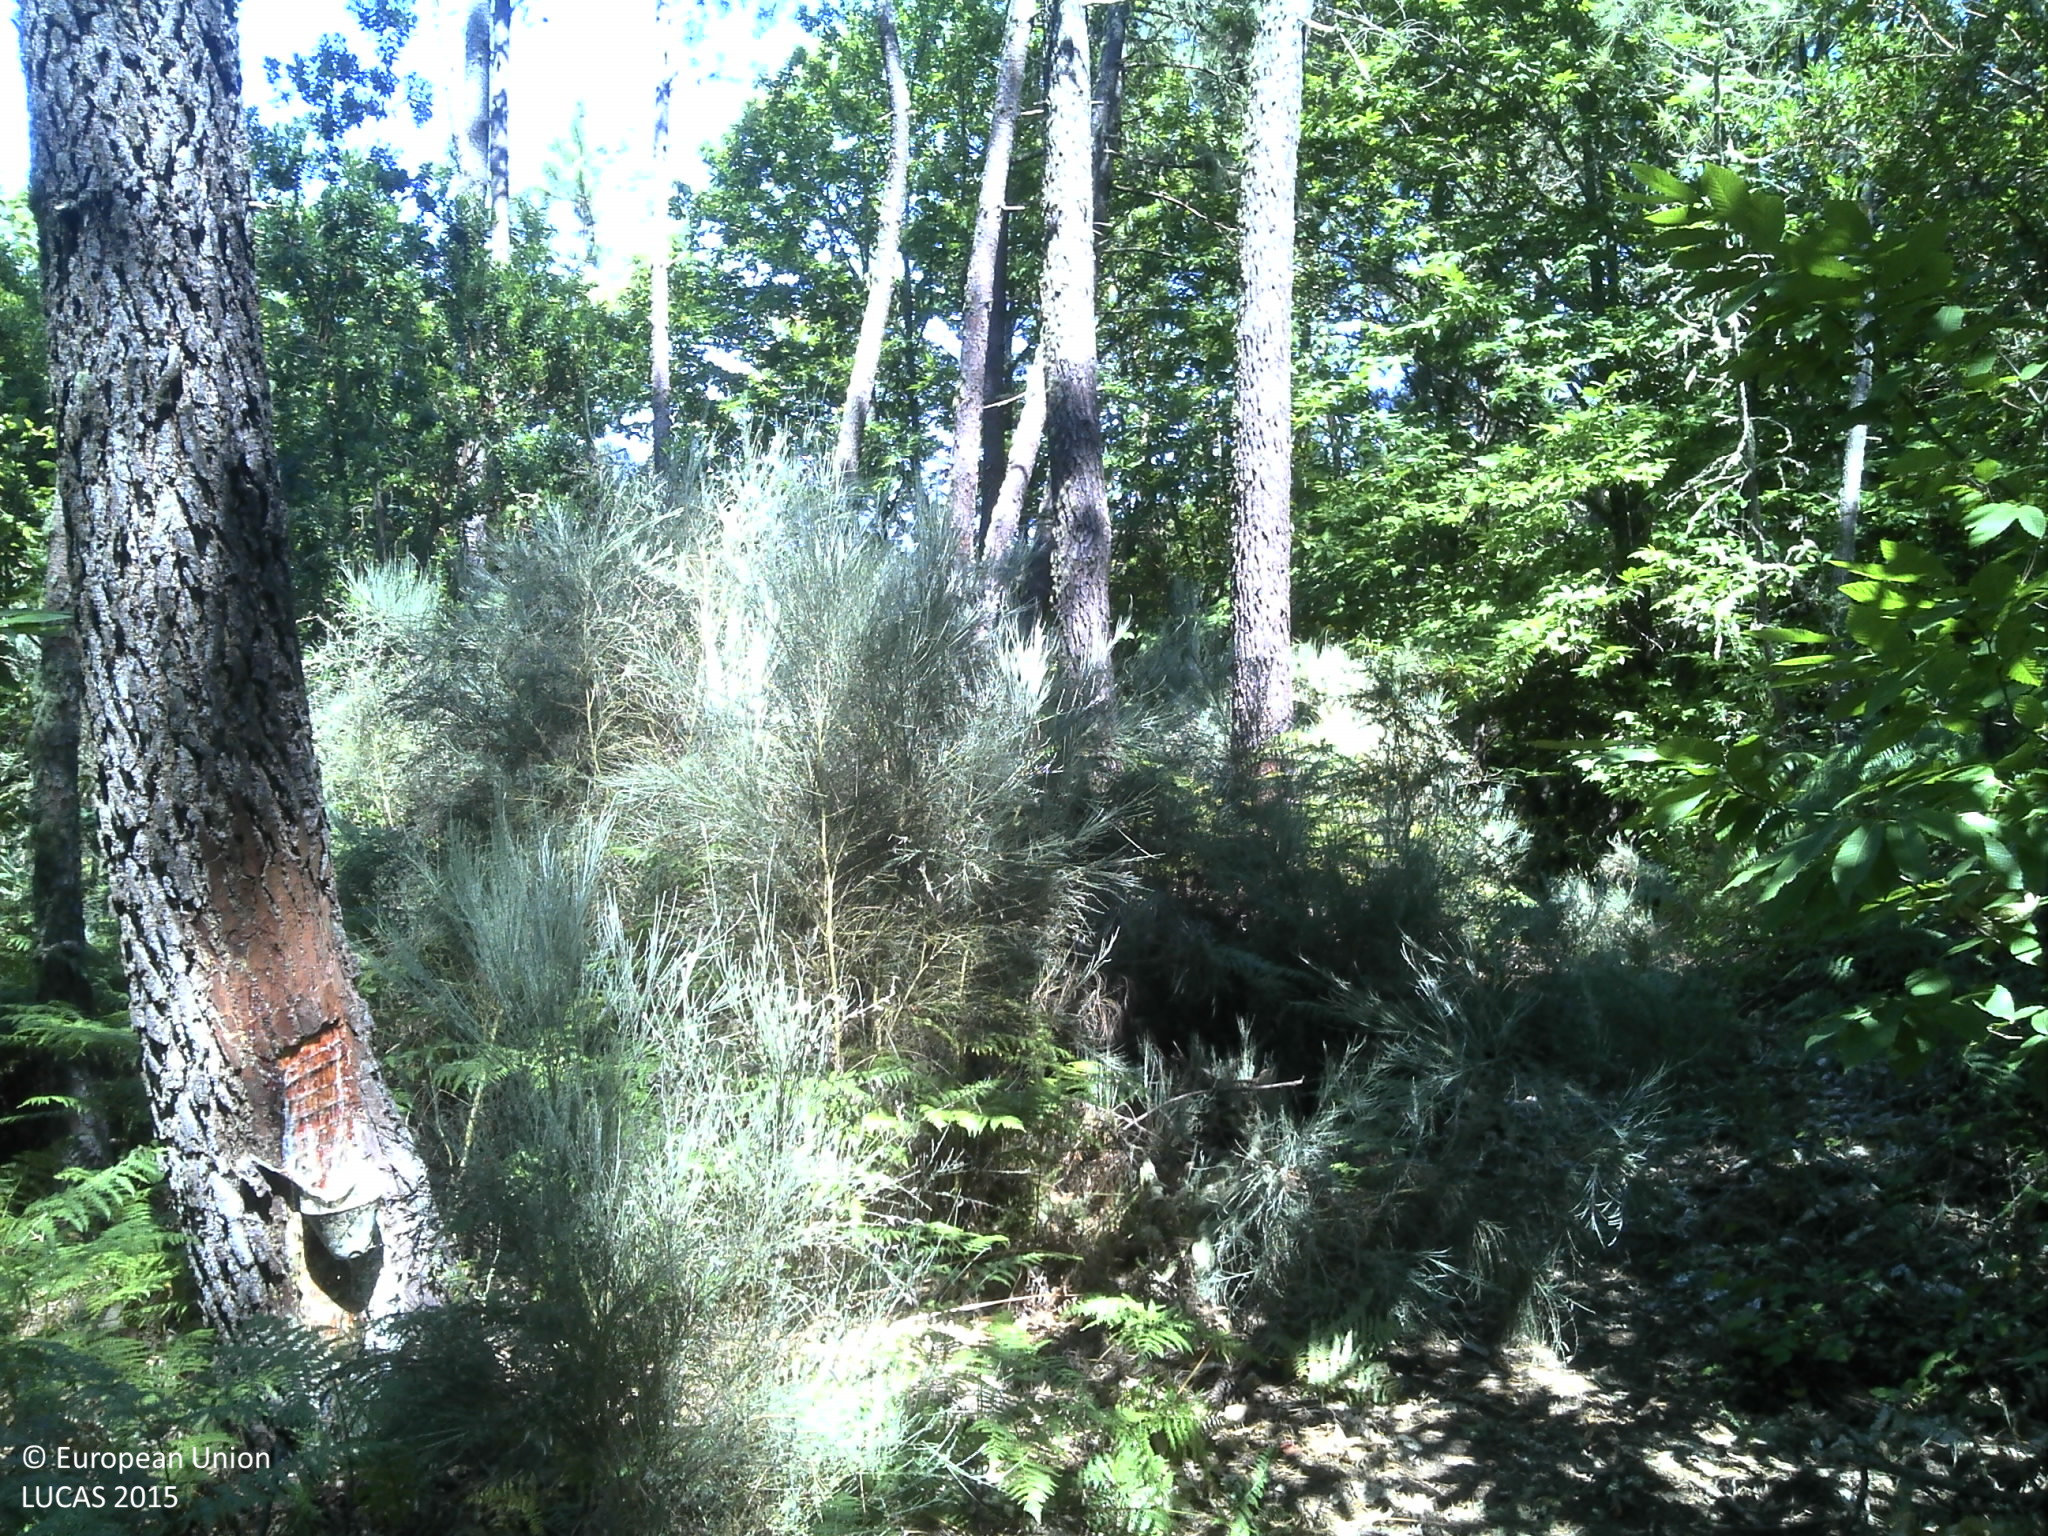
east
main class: Woodland
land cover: Broadleaved woodland
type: thermophilous deciduous forest
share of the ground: 50 - 75 %
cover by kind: broadleaved forest trees 70 %, shrubs 20 %, herbaceous plants 5 %, unconsolidated bare surface 5 %
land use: Forestry
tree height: > 5 m
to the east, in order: Broadleaved woodland; Pine dominated mixed woodland; Pine dominated coniferous woodland; Pine dominated mixed woodland; Broadleaved woodland; Dry stone walls; Broadleaved woodland; Dry stone walls; Broadleaved woodland; Artificial constructions in urban areas; Broadleaved woodland; Shrubland without tree cover; Shrubland with sparse tree cover
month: July
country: PT
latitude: 40.2887
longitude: -7.8912
